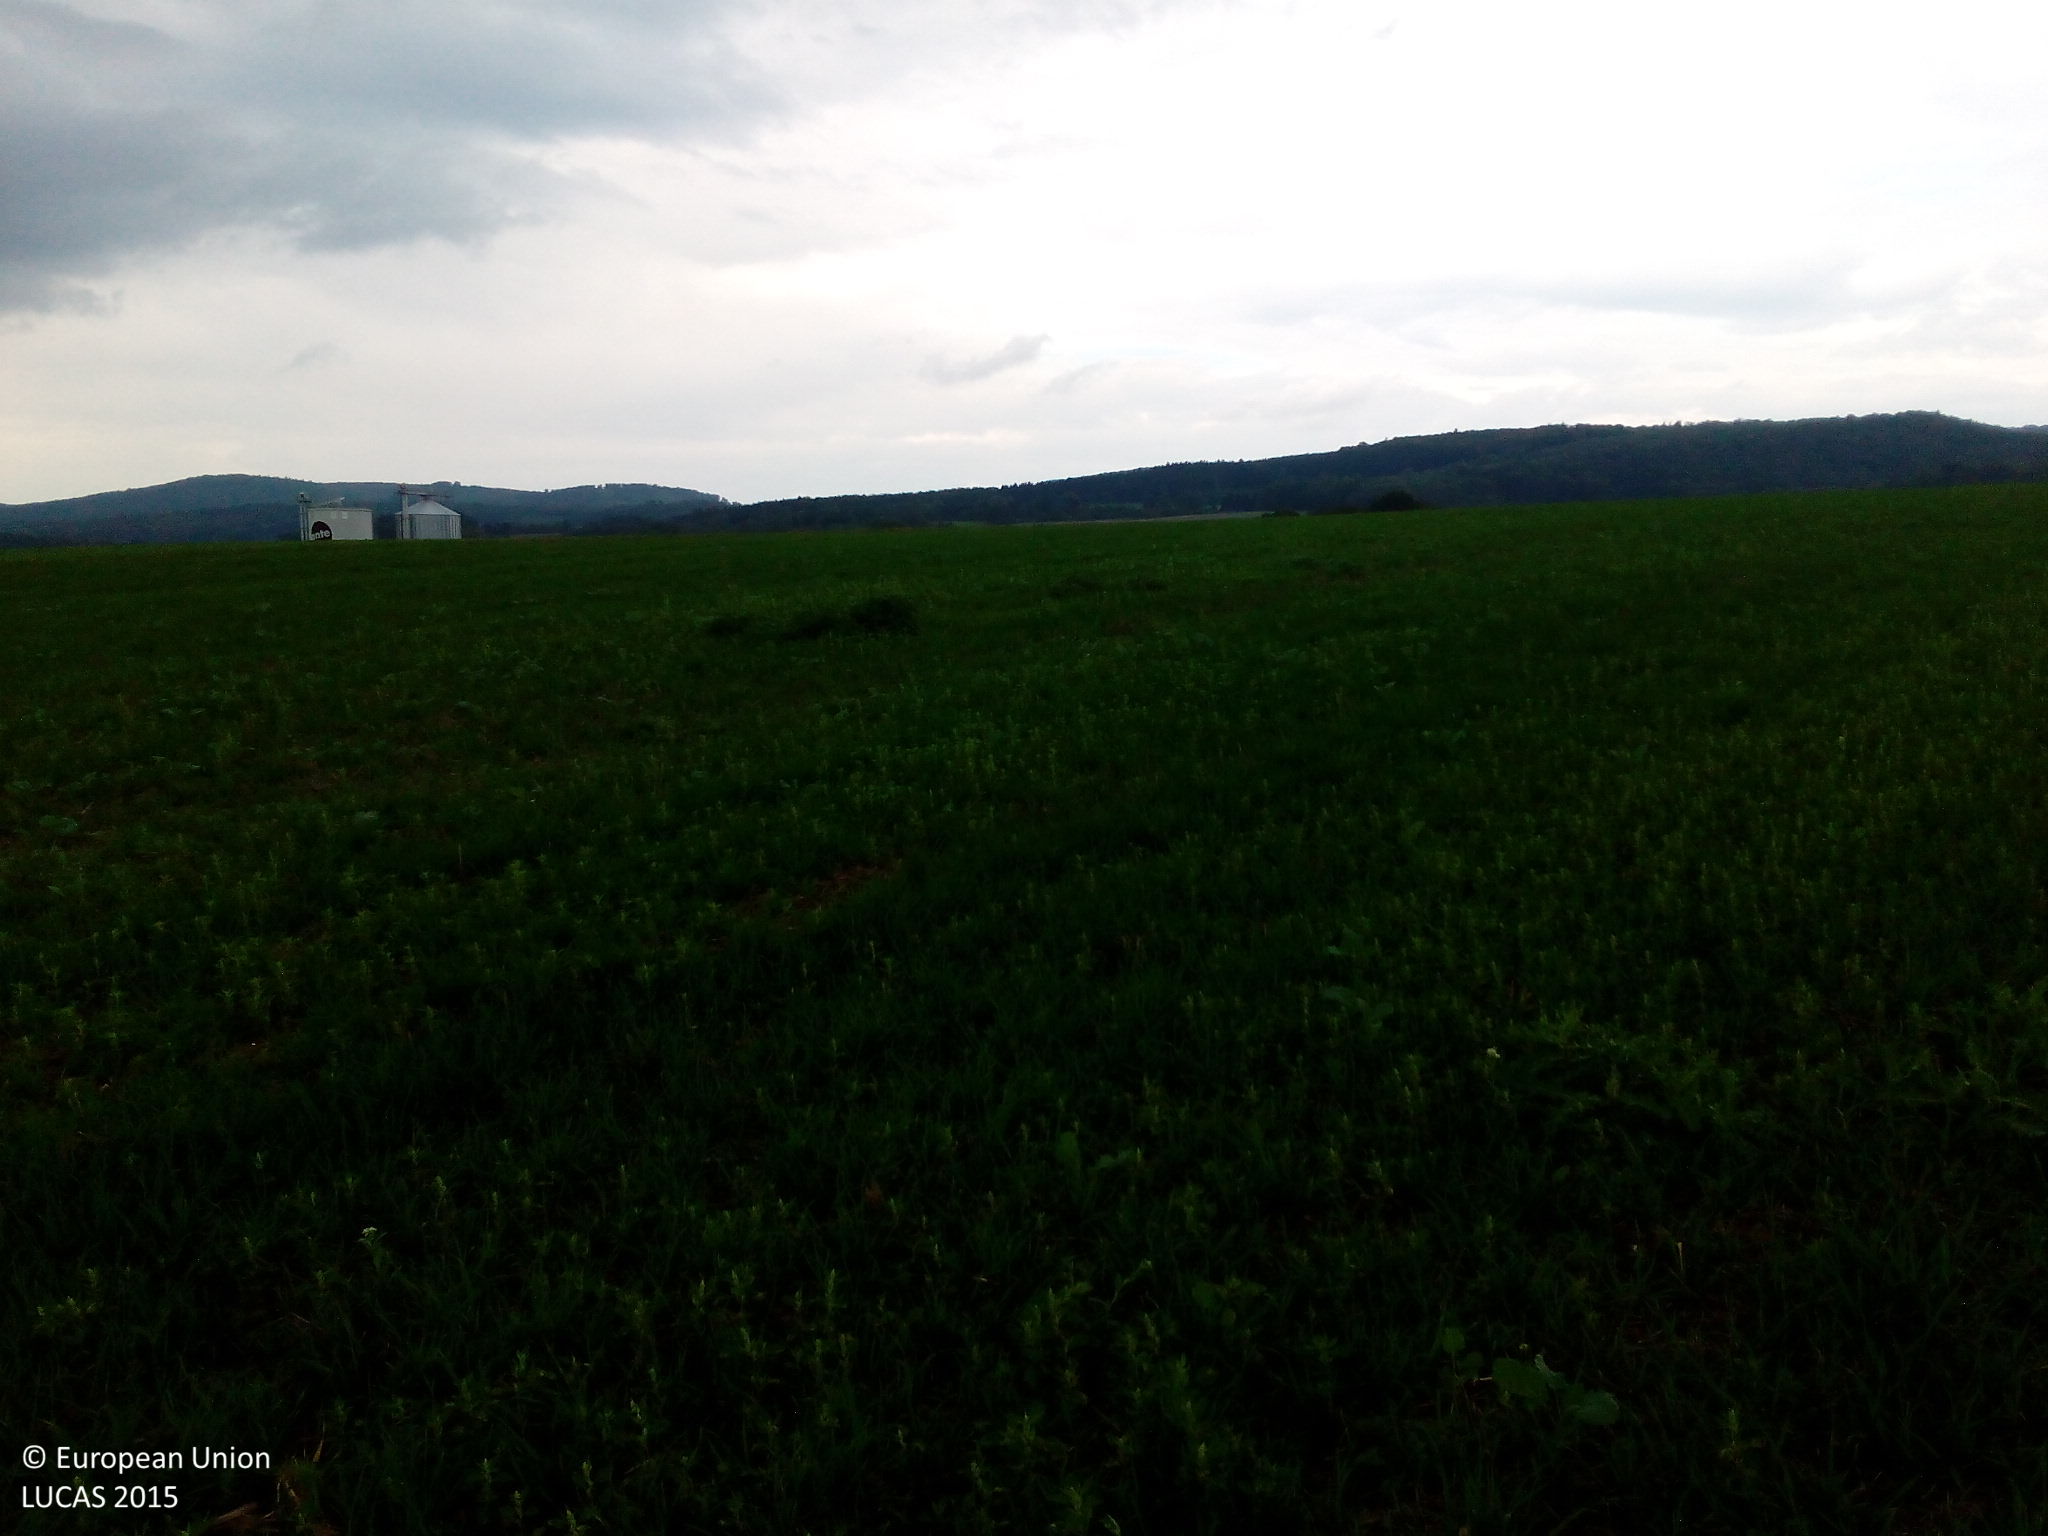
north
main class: Cropland
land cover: Common wheat
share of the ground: 50 - 75 %
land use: Agriculture (excluding fallow land and kitchen gardens)
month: September
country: DE
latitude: 51.5107
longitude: 10.9651
